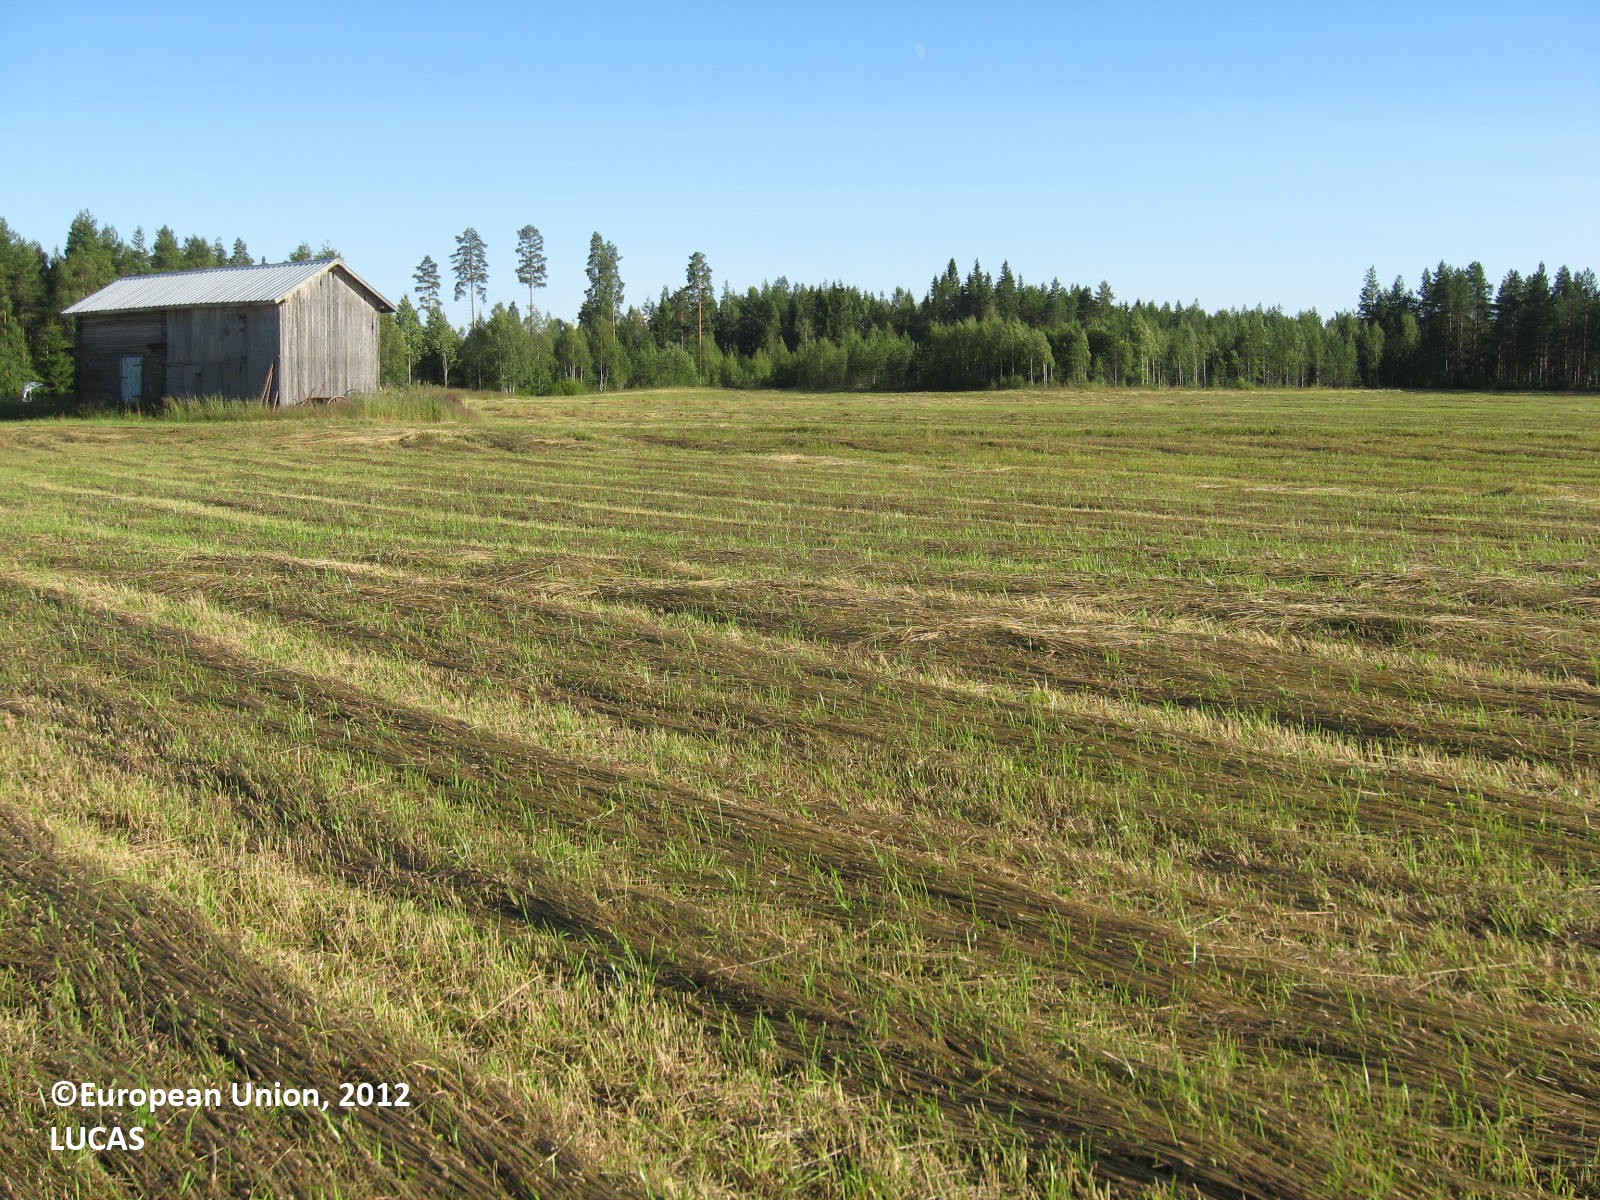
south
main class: Cropland
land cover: Temporary grasslands
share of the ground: > 75 %
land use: Agriculture (excluding fallow land and kitchen gardens)
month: July
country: FI
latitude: 62.1110
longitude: 22.4570
